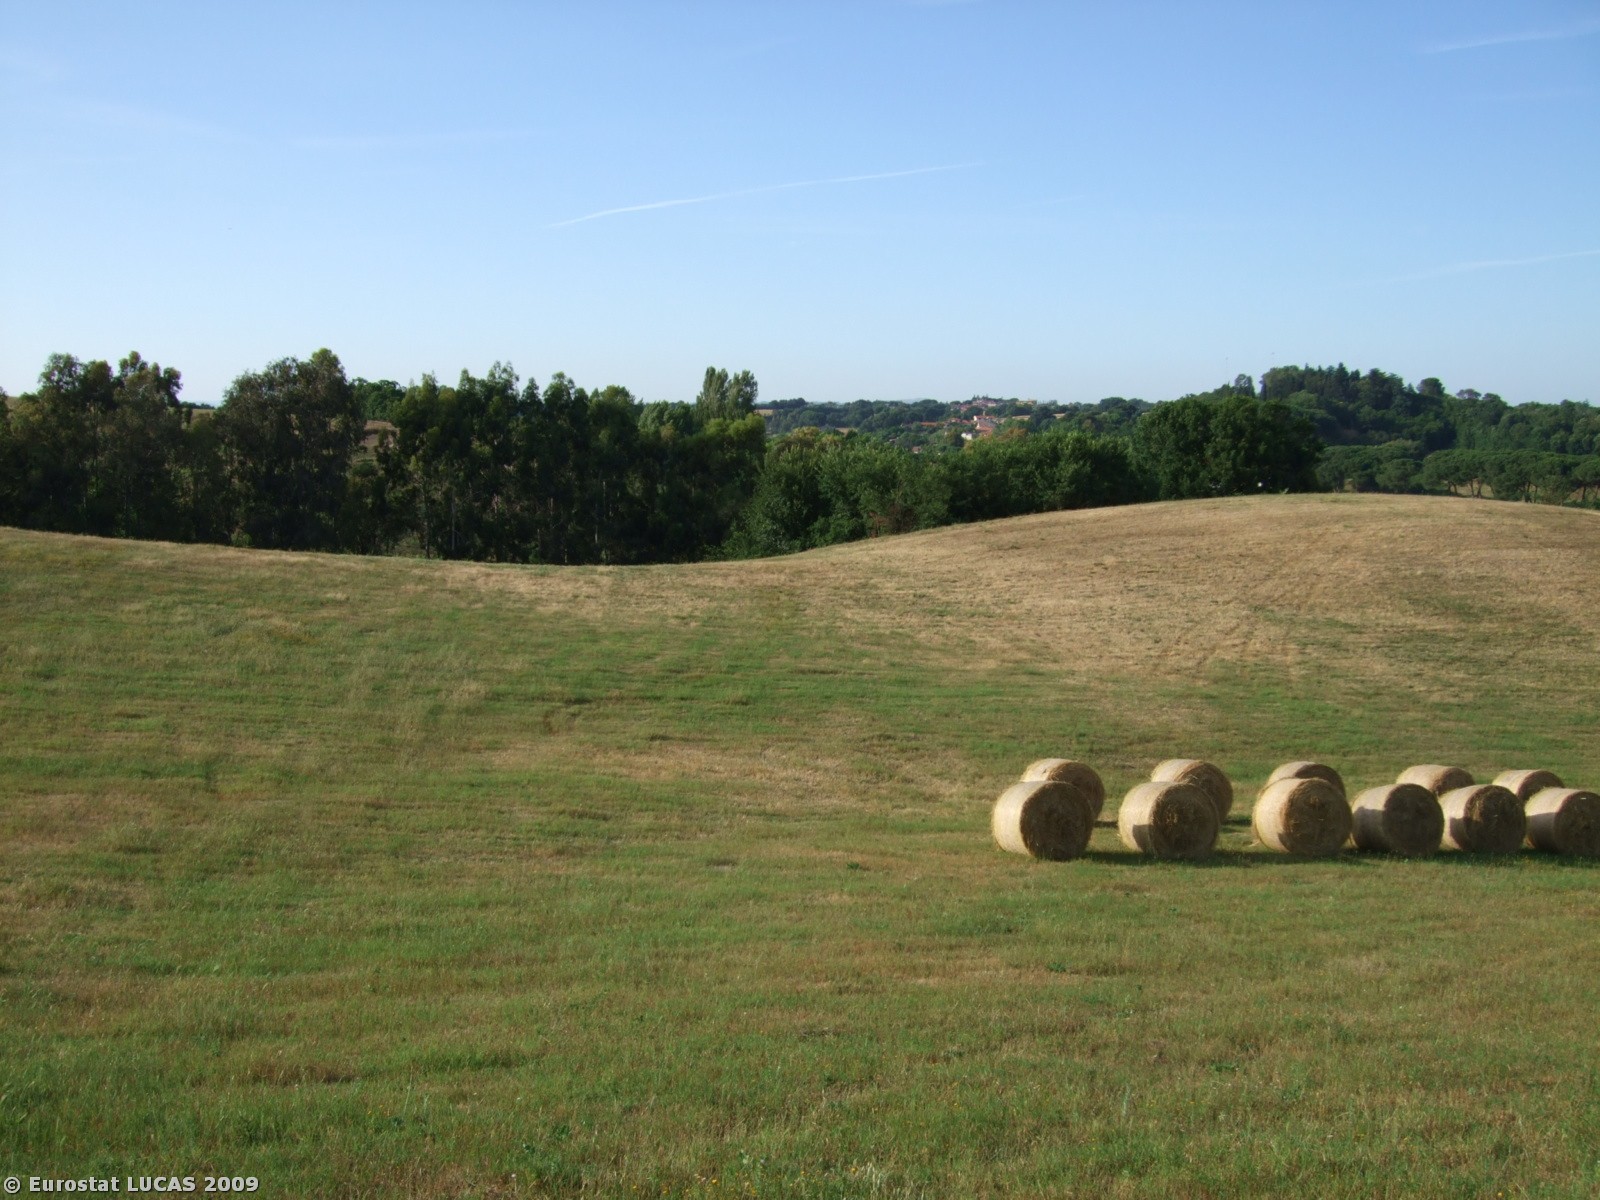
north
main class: Grassland
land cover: Grassland without tree/shrub cover
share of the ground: > 75 %
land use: Agriculture (excluding fallow land and kitchen gardens)
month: June
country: IT
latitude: 41.9402
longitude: 12.3432
